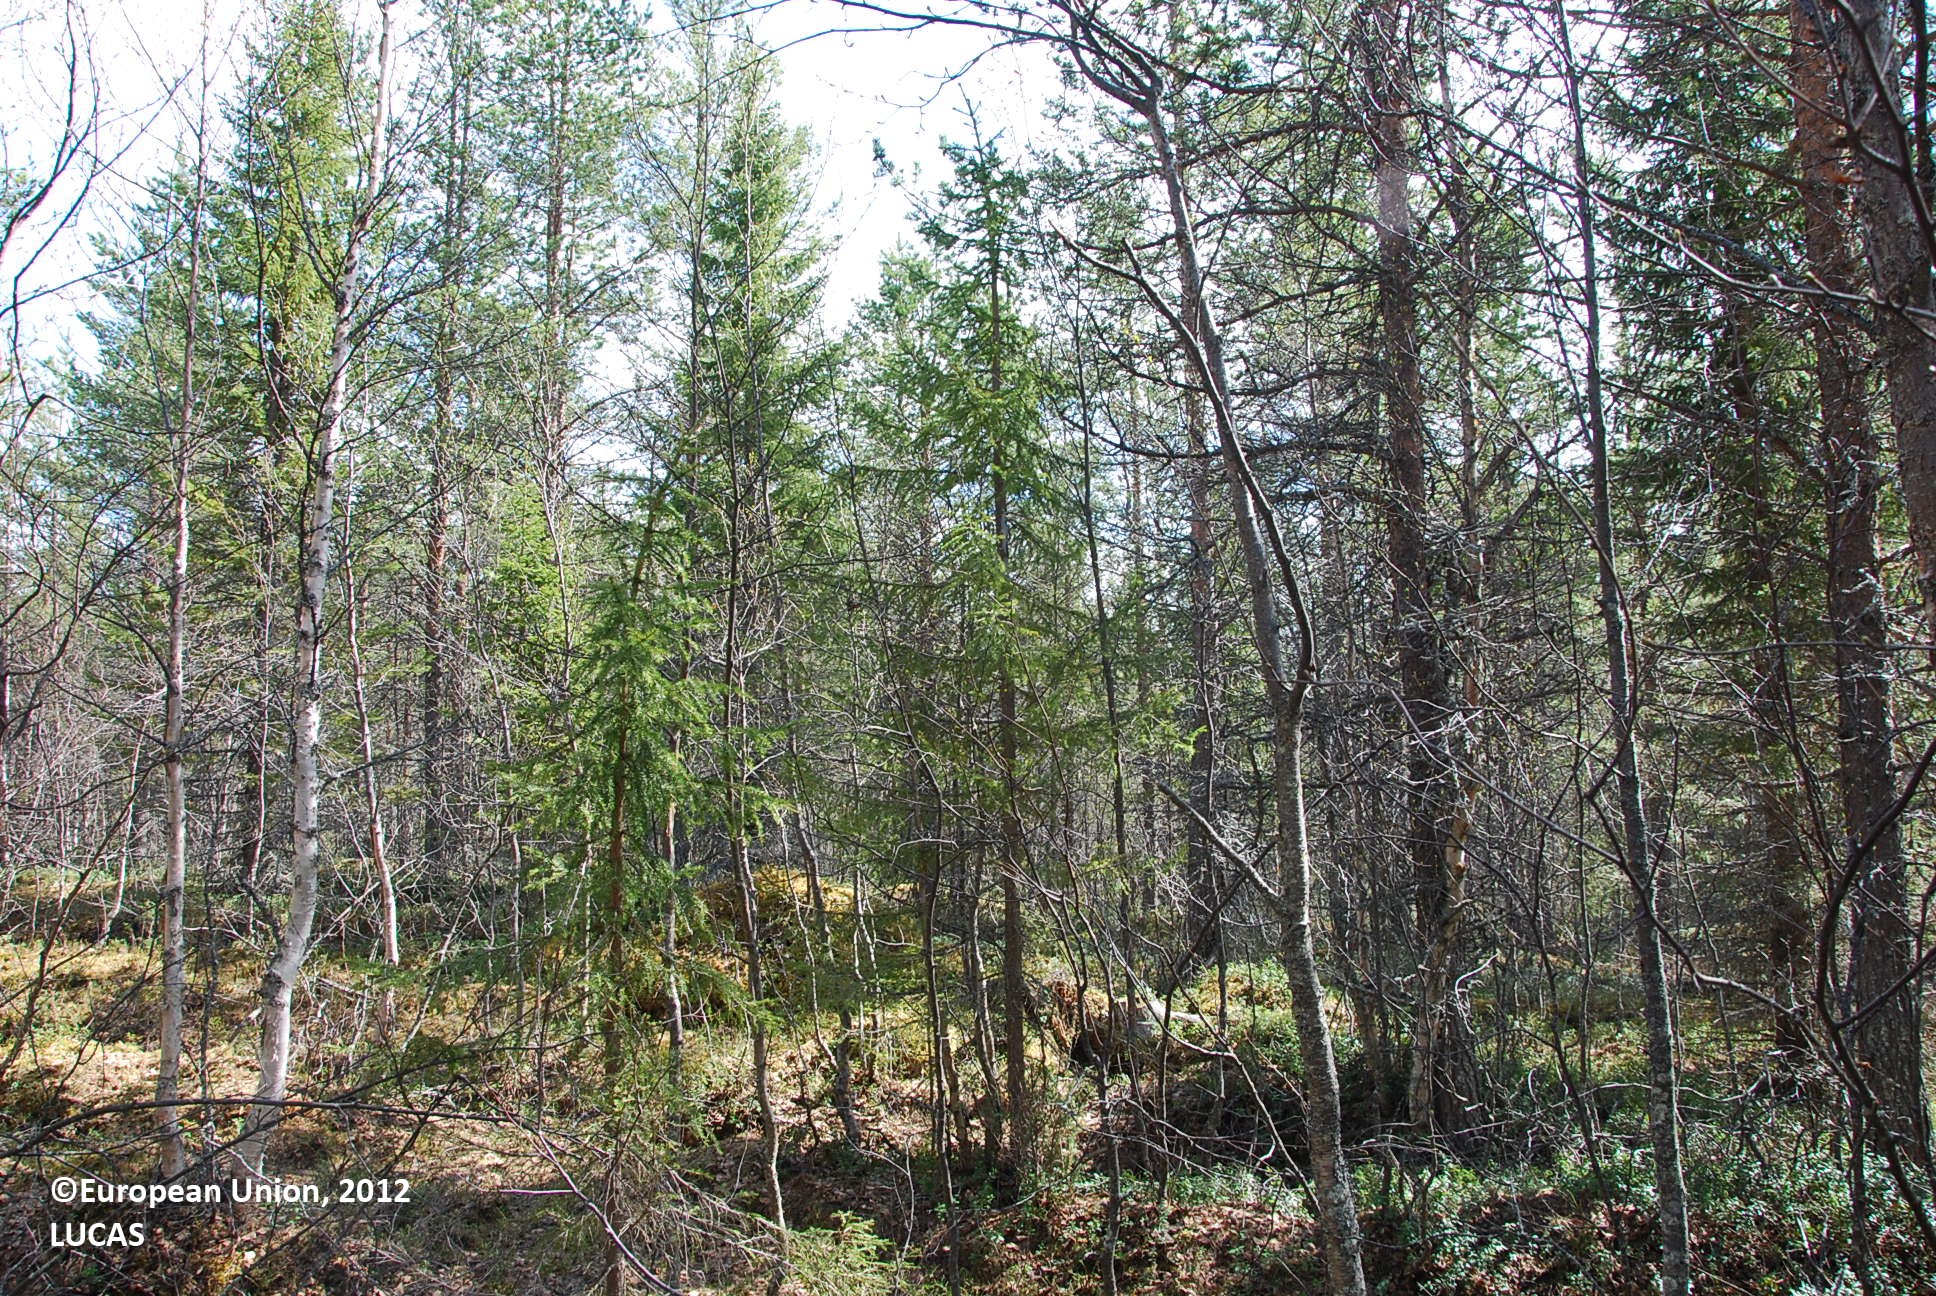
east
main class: Woodland
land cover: Pine dominated mixed woodland
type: boreal forest
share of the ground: > 75 %
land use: Forestry
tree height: > 5 m
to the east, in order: Pine dominated mixed woodland
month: May
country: FI
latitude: 66.6956
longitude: 28.7012
